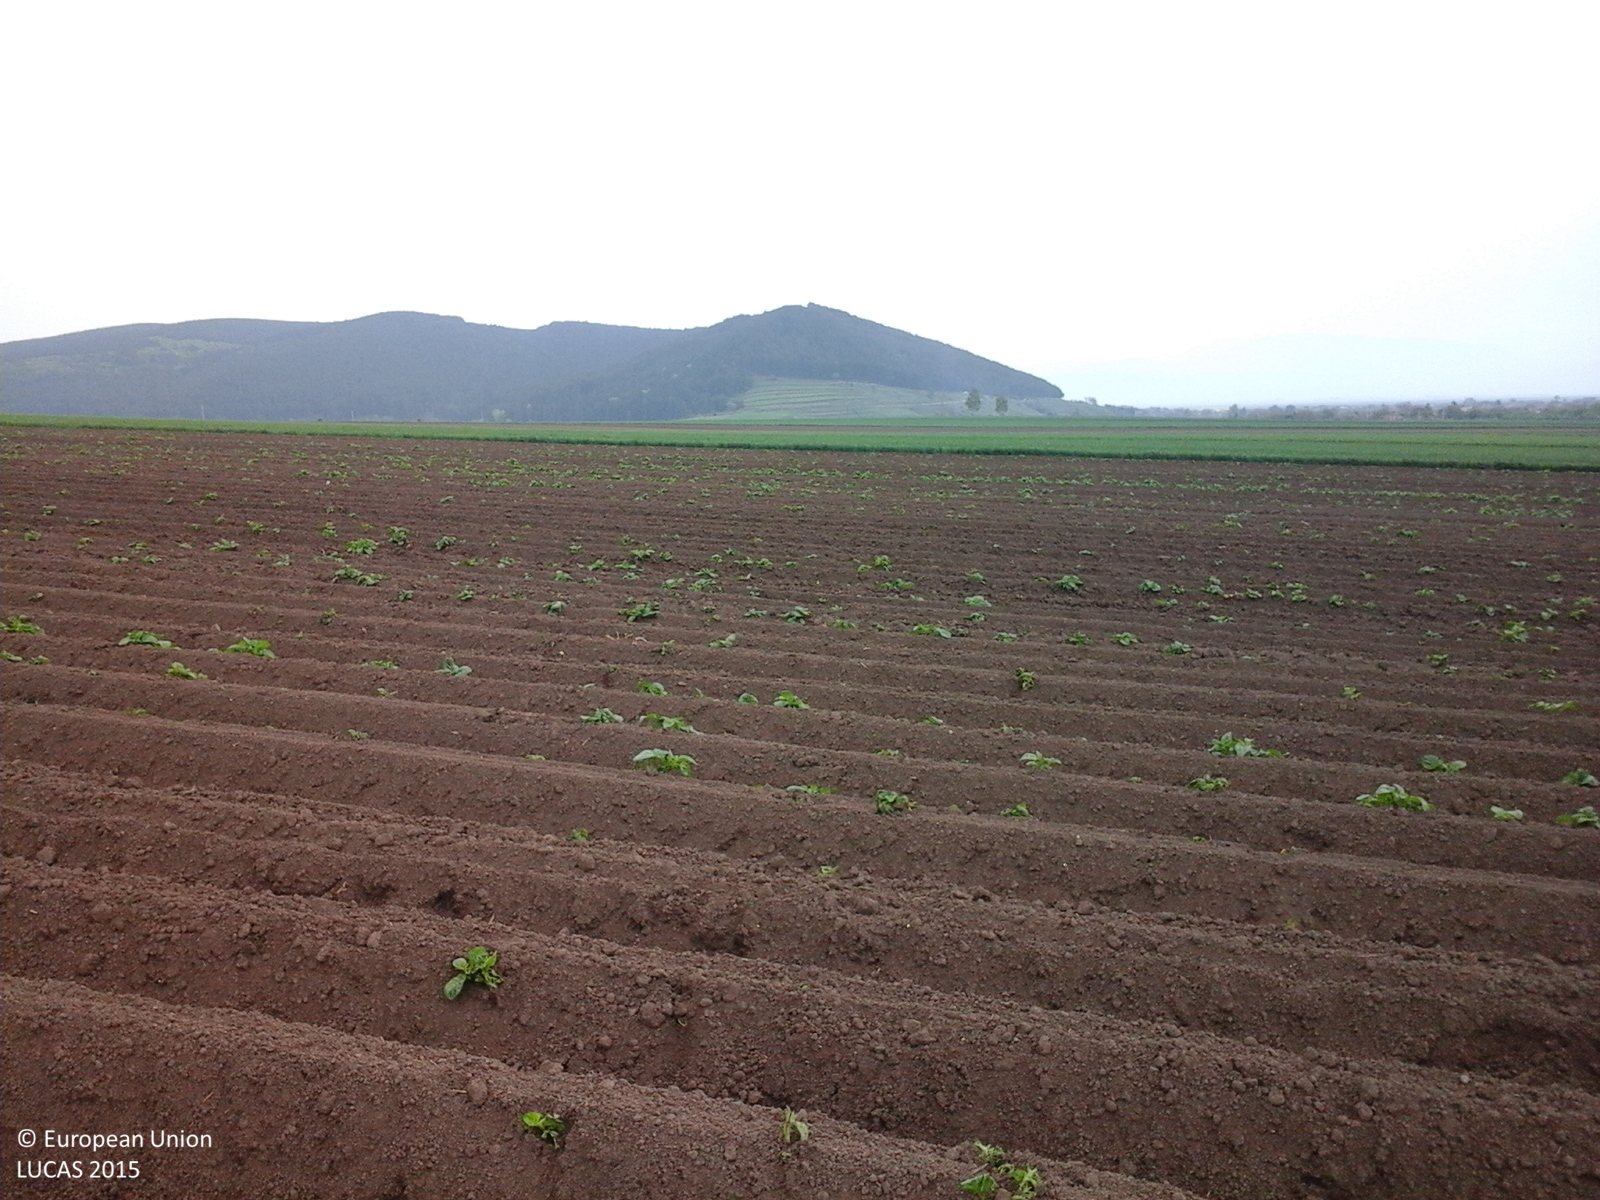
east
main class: Cropland
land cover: Potatoes
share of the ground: < 10 %
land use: Agriculture (excluding fallow land and kitchen gardens)
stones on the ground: < 10 %
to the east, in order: Potatoes; Common wheat; Potatoes; Common wheat; Barley; Common wheat
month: May
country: RO
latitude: 46.0560
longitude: 26.1090
